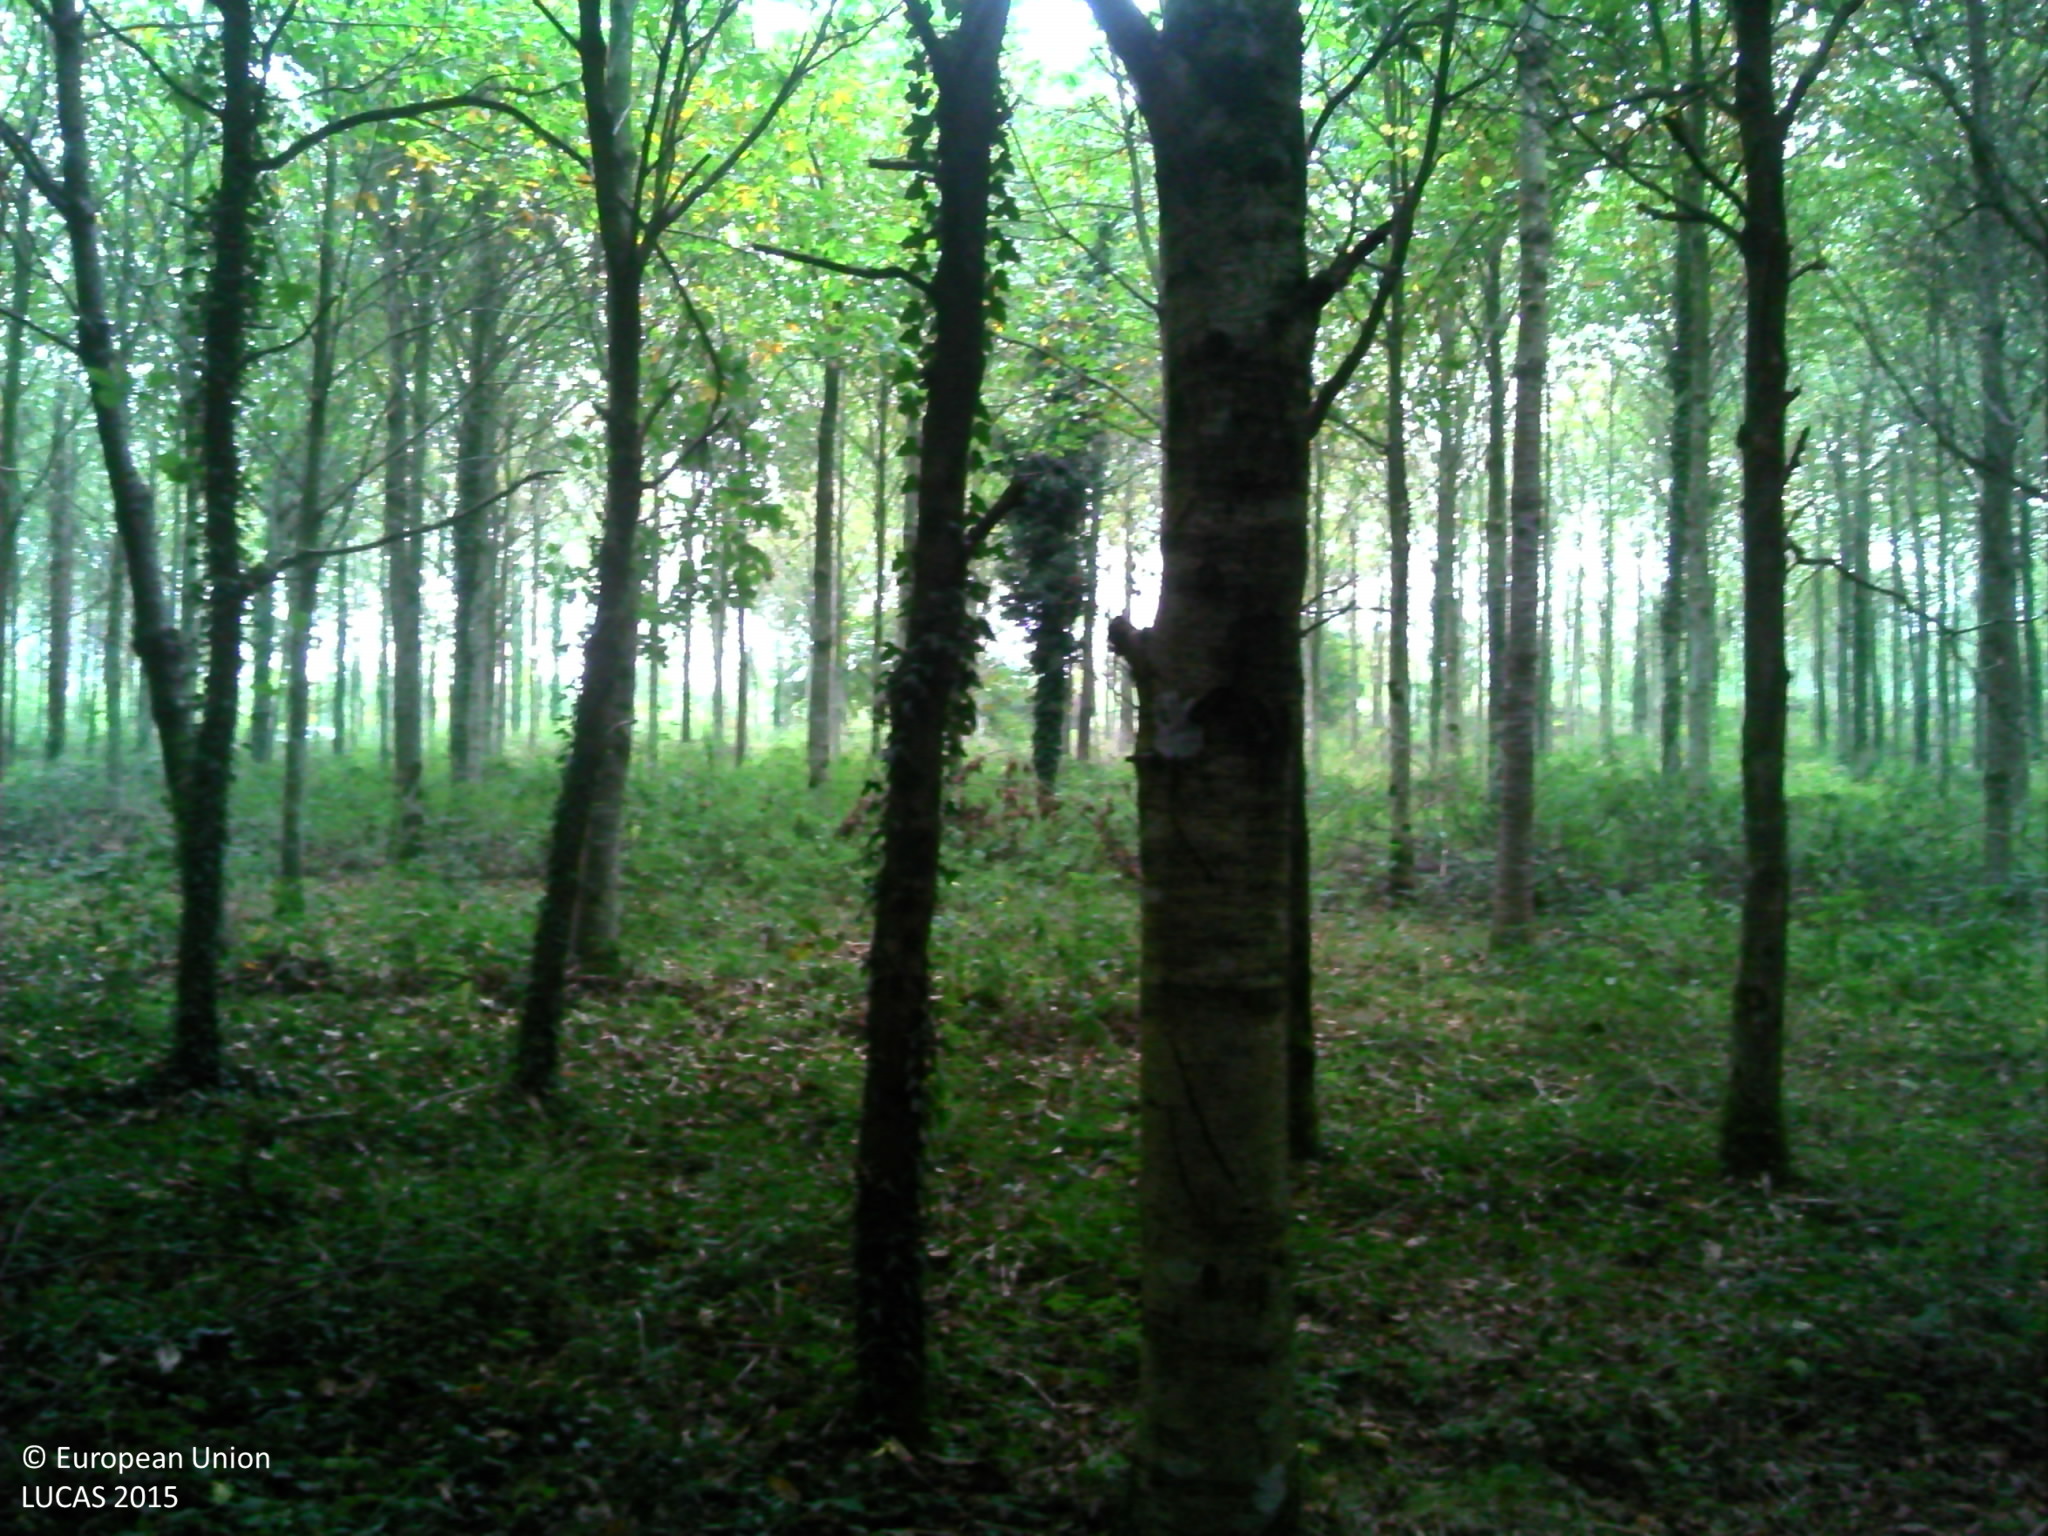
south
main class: Woodland
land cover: Broadleaved woodland
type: mesophytic deciduous forest
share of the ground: > 75 %
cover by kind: broadleaved forest trees 100 %
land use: Forestry
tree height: > 5 m
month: October
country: FR
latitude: 47.8903
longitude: -2.3477
